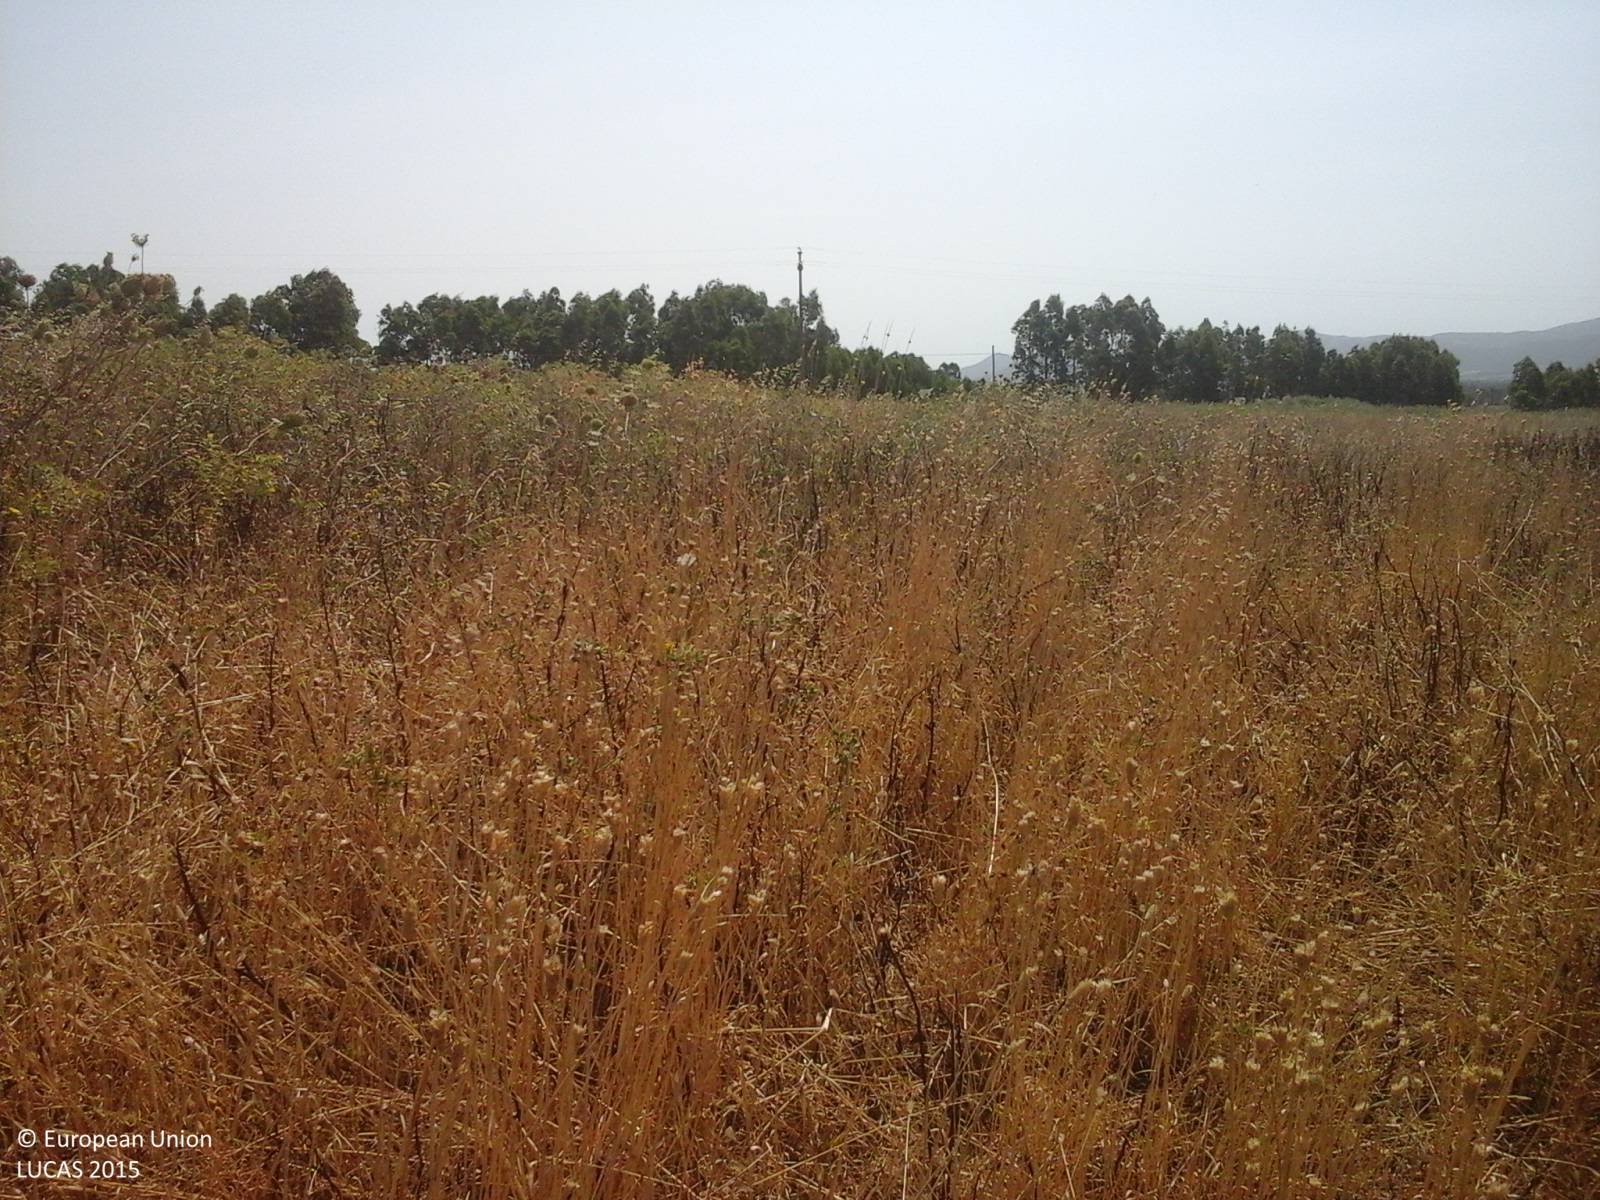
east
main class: Grassland
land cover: Grassland without tree/shrub cover
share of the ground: > 75 %
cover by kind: herbaceous plants 90 %, shrubs 5 %, unconsolidated bare surface 5 %
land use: Agriculture (excluding fallow land and kitchen gardens)
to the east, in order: Grassland without tree/shrub cover; Electric lines; Grassland without tree/shrub cover; Fences; Paved roads, cycling and walking lanes; Fences; Grassland without tree/shrub cover; Tracks; Grass margins; Electric lines; Fences; Other coniferous woodland; Fences; Grassland without tree/shrub cover
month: July
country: IT
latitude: 39.2786
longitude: 8.5598
